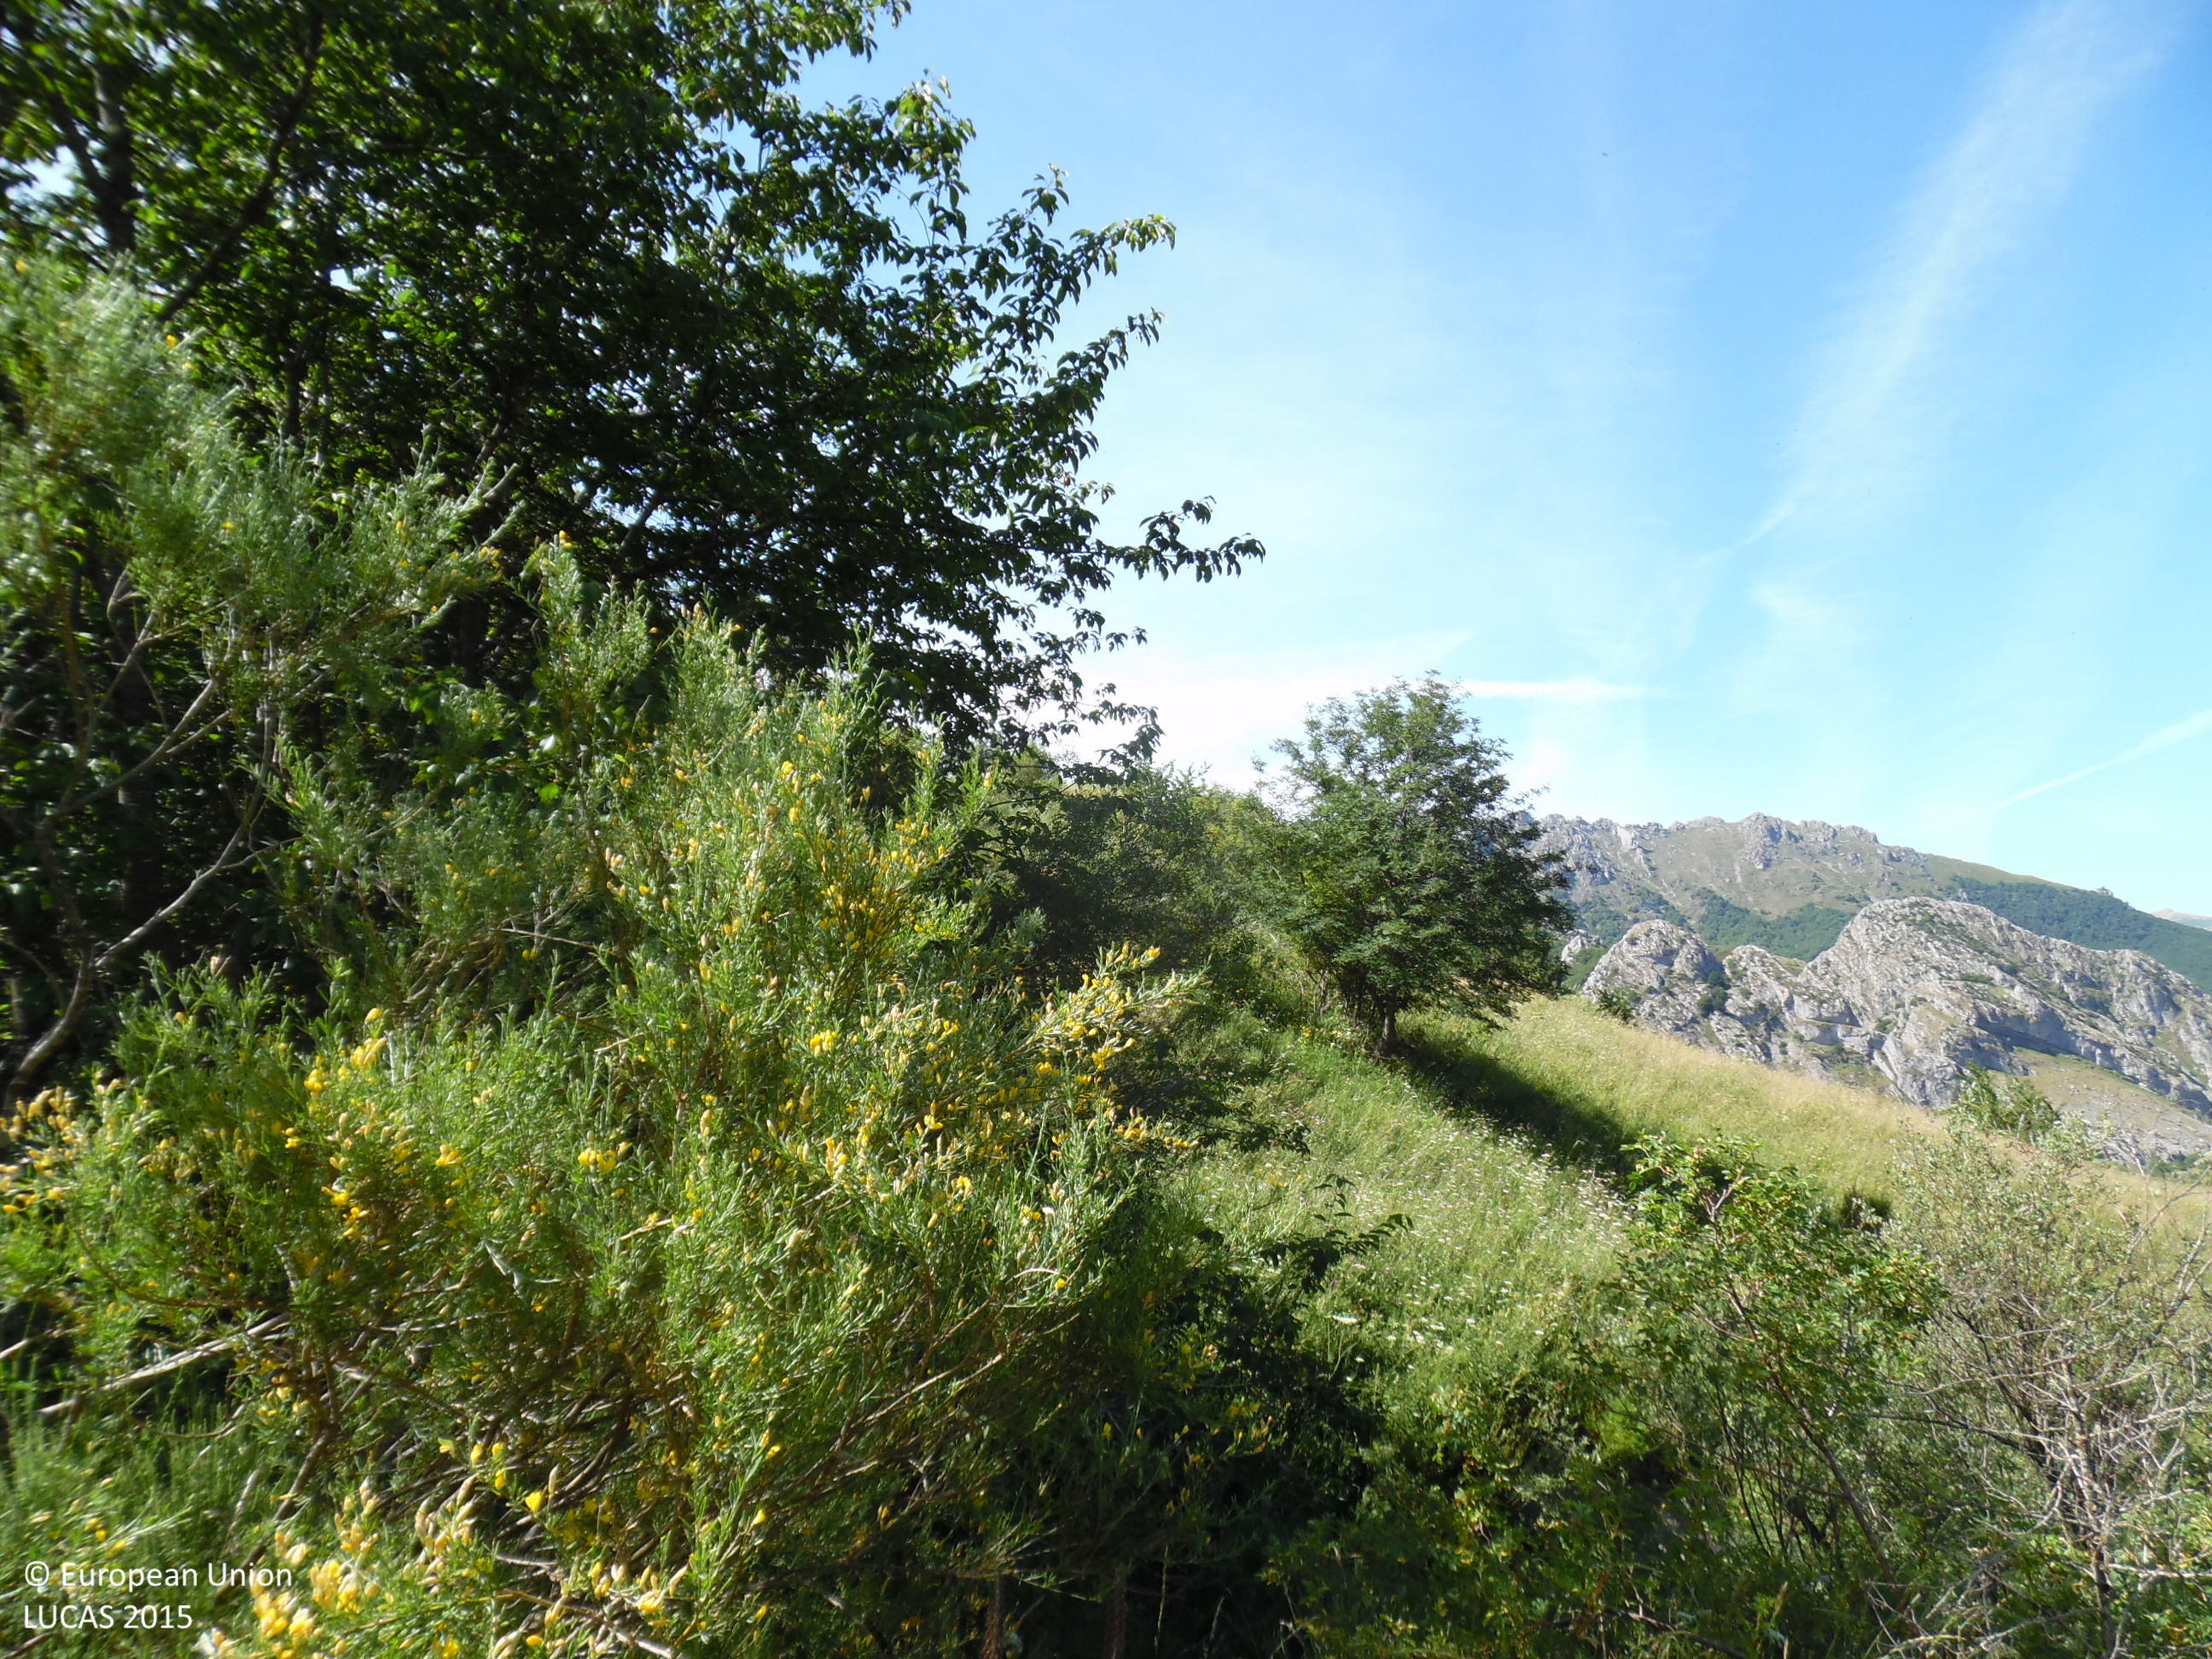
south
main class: Woodland
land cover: Broadleaved woodland
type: thermophilous deciduous forest
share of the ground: > 75 %
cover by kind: broadleaved forest trees 100 %
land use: Forestry
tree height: > 5 m
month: July
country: ES
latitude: 42.9912
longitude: -5.5179
